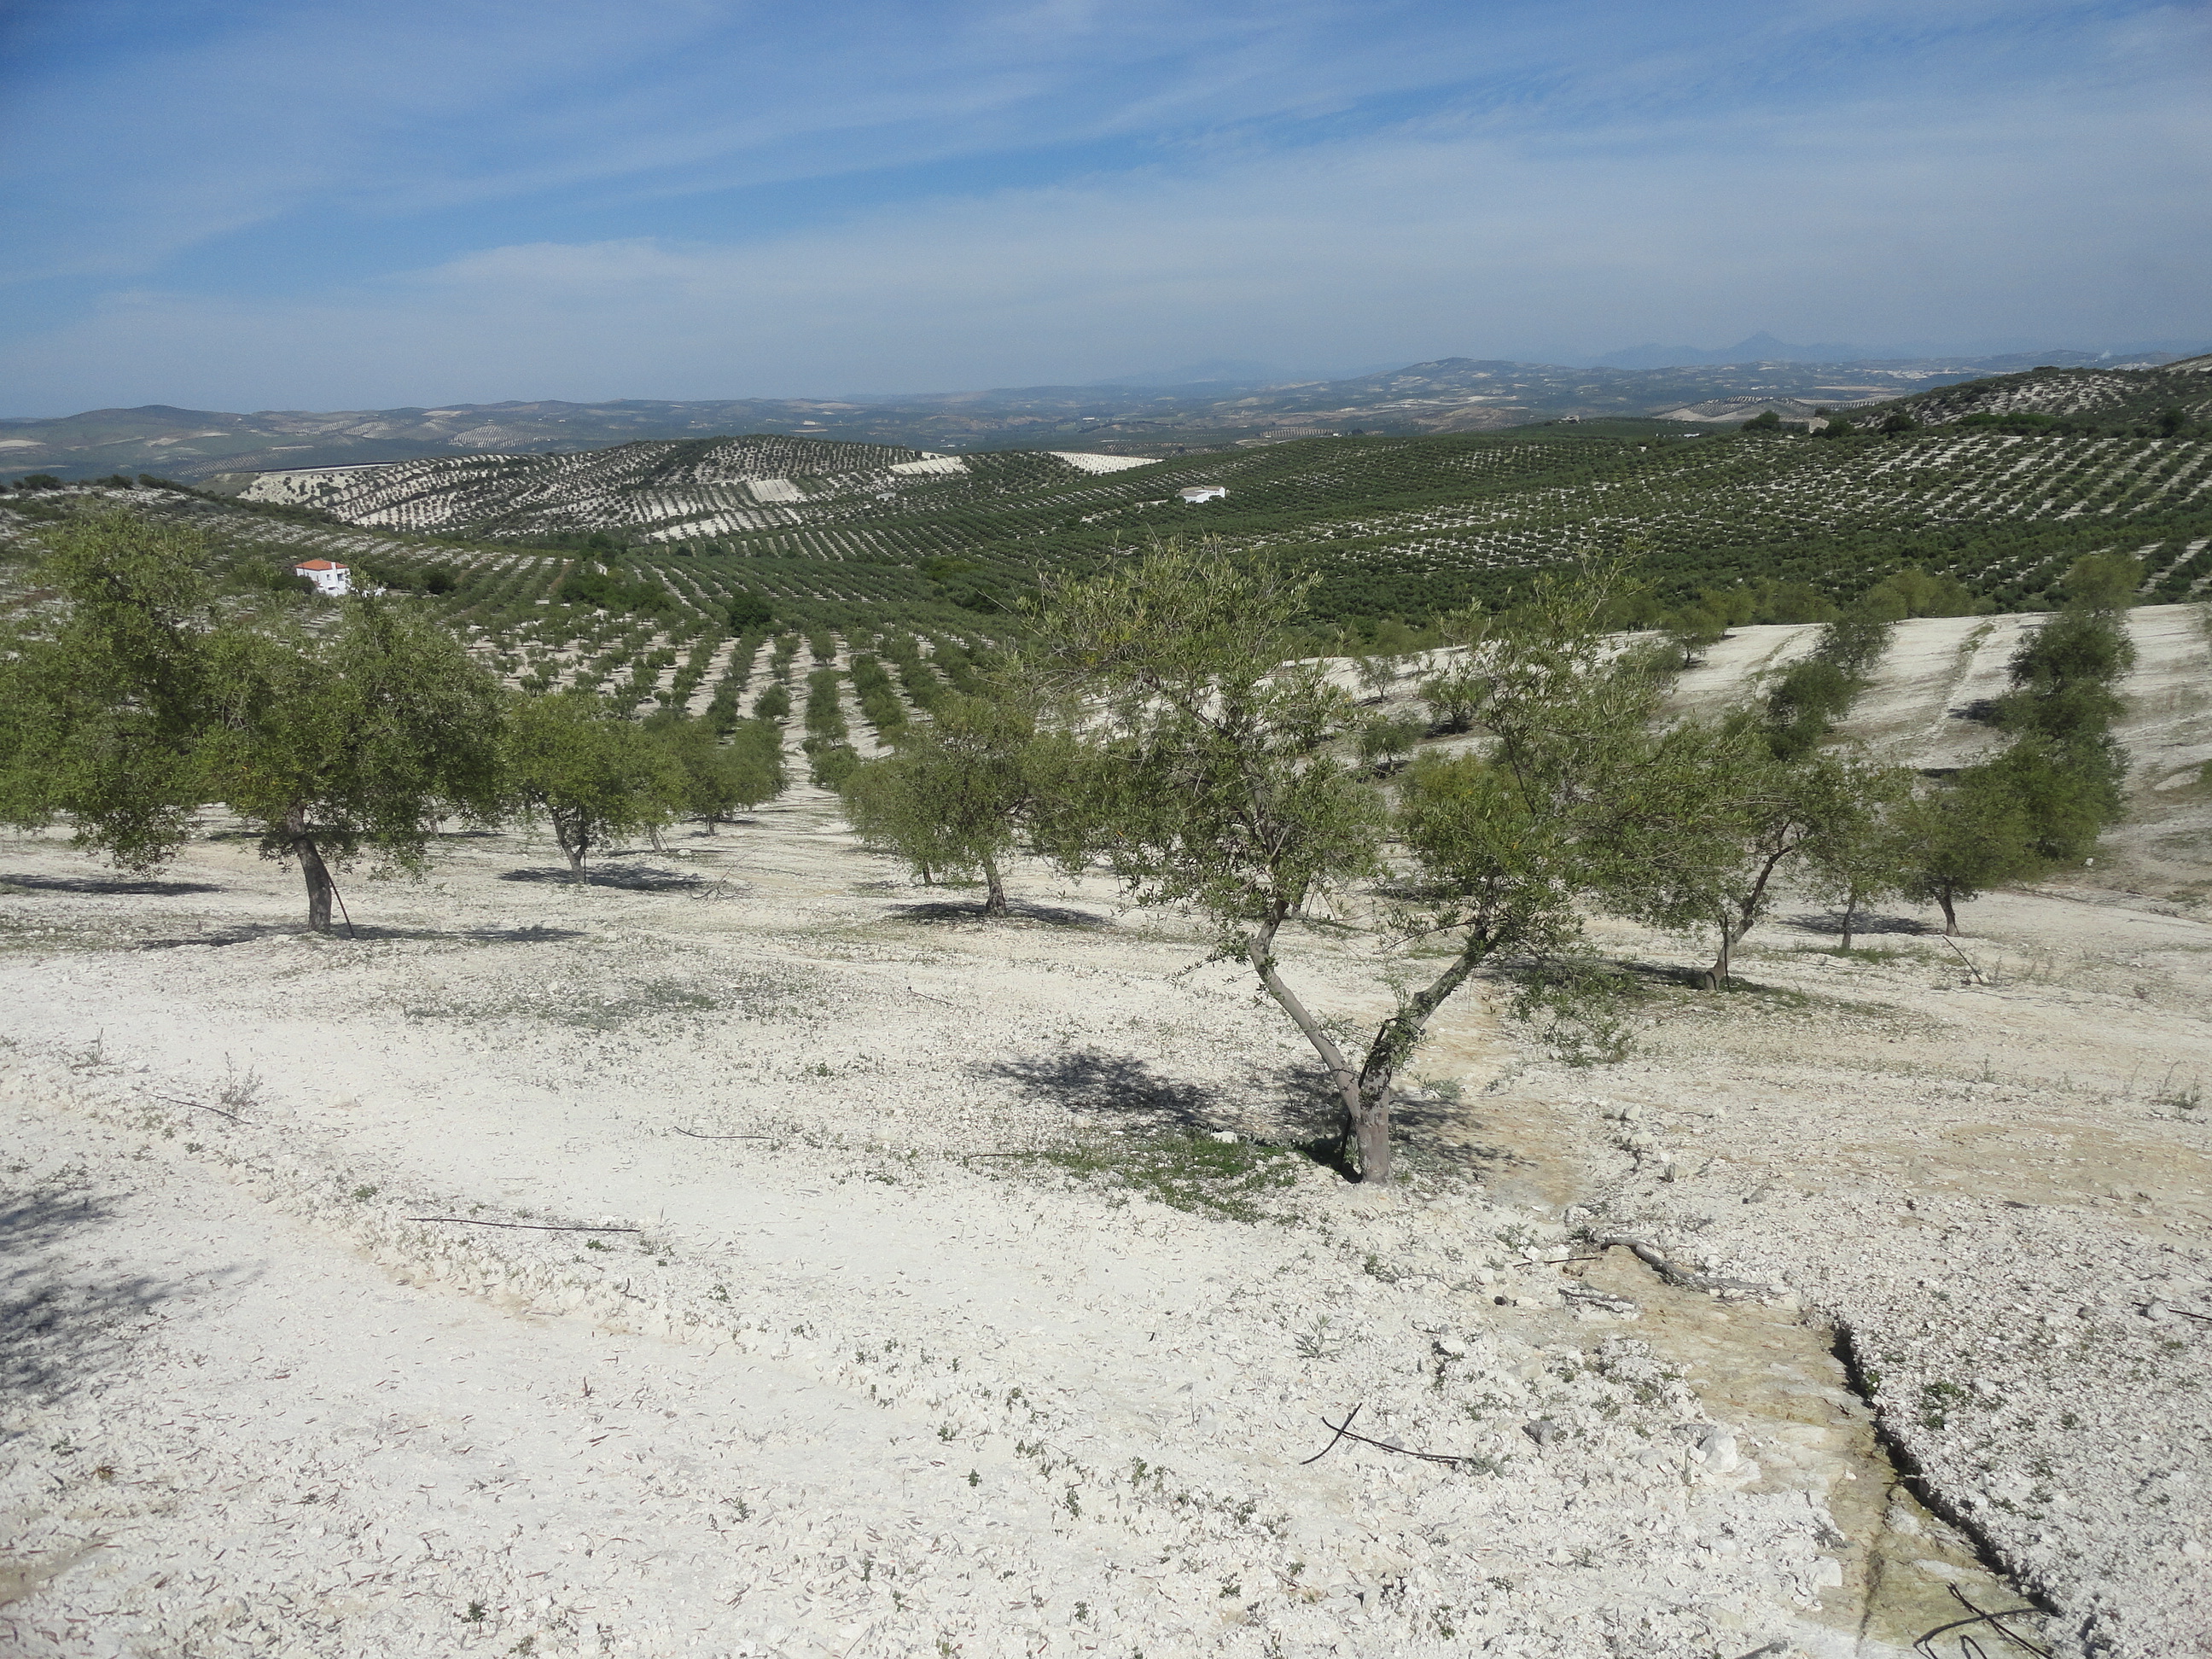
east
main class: Cropland
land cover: Olive groves
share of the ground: 25 - 50 %
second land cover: Other bare soil
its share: > 75 %
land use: Agriculture (excluding fallow land and kitchen gardens)
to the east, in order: Olive groves; Other bare soil; Other structural elements; Olive groves; Groves; Olive groves
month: April
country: ES
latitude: 37.6477
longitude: -4.4570
